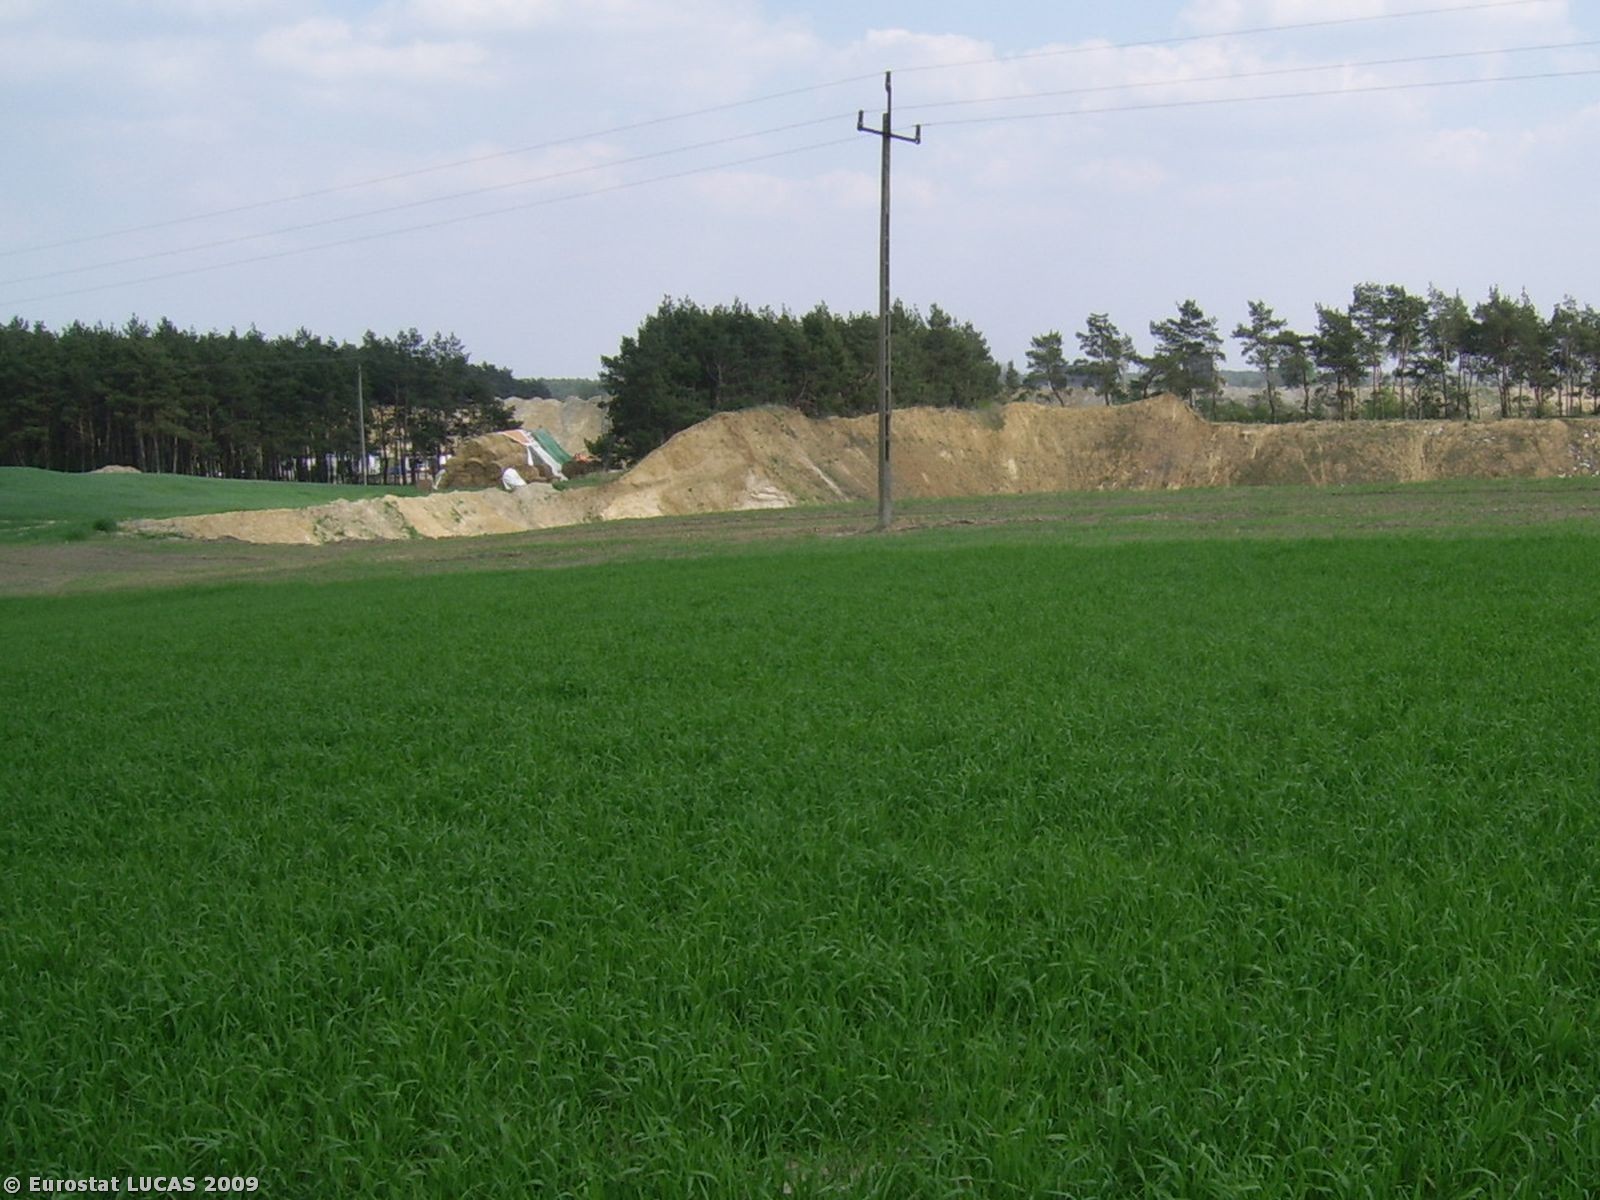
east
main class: Cropland
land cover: Rye
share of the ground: > 75 %
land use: Agriculture (excluding fallow land and kitchen gardens)
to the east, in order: Rye; Electric lines; Rye; Bare land; Grassland without tree/shrub cover; Tracks; Broadleaved woodland
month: April
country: PL
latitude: 52.3003
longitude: 16.9458
